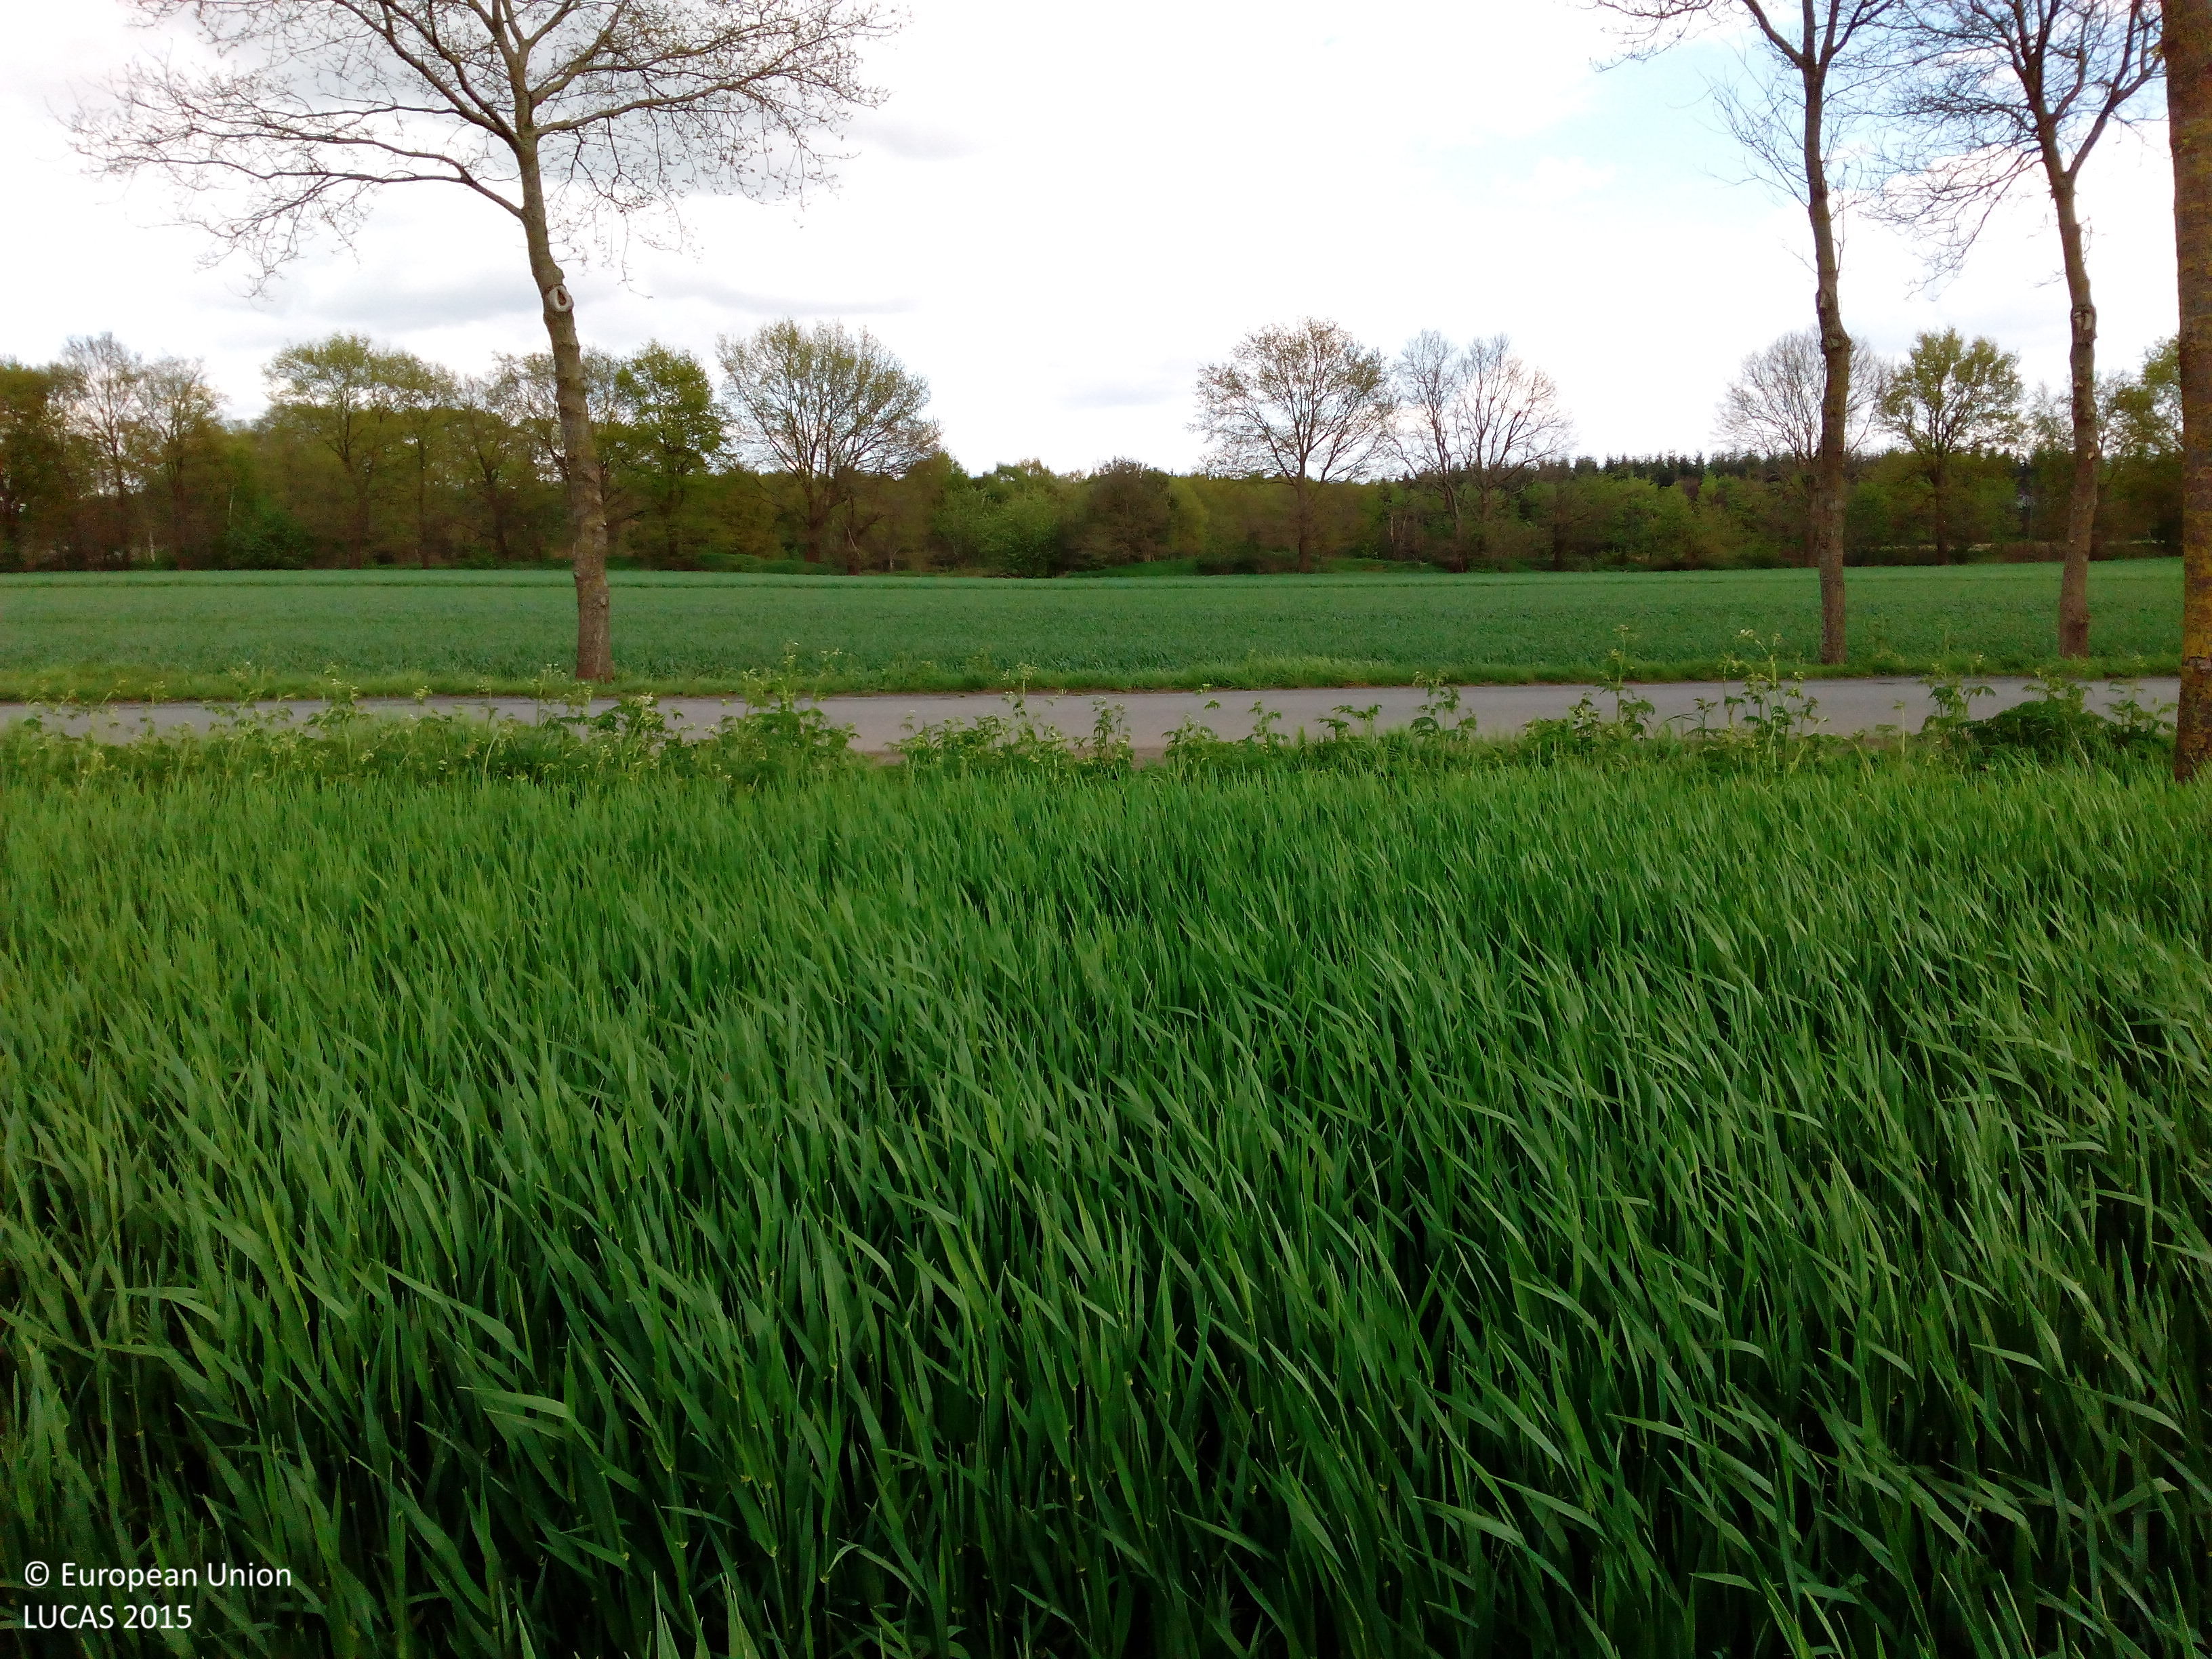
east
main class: Cropland
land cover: Barley
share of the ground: > 75 %
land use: Agriculture (excluding fallow land and kitchen gardens)
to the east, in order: Barley; Lines of trees; Paved roads, cycling and walking lanes; Lines of trees; Rye; Broadleaved woodland; Maize; Broadleaved woodland
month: May
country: DE
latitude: 52.8640
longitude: 7.9953
